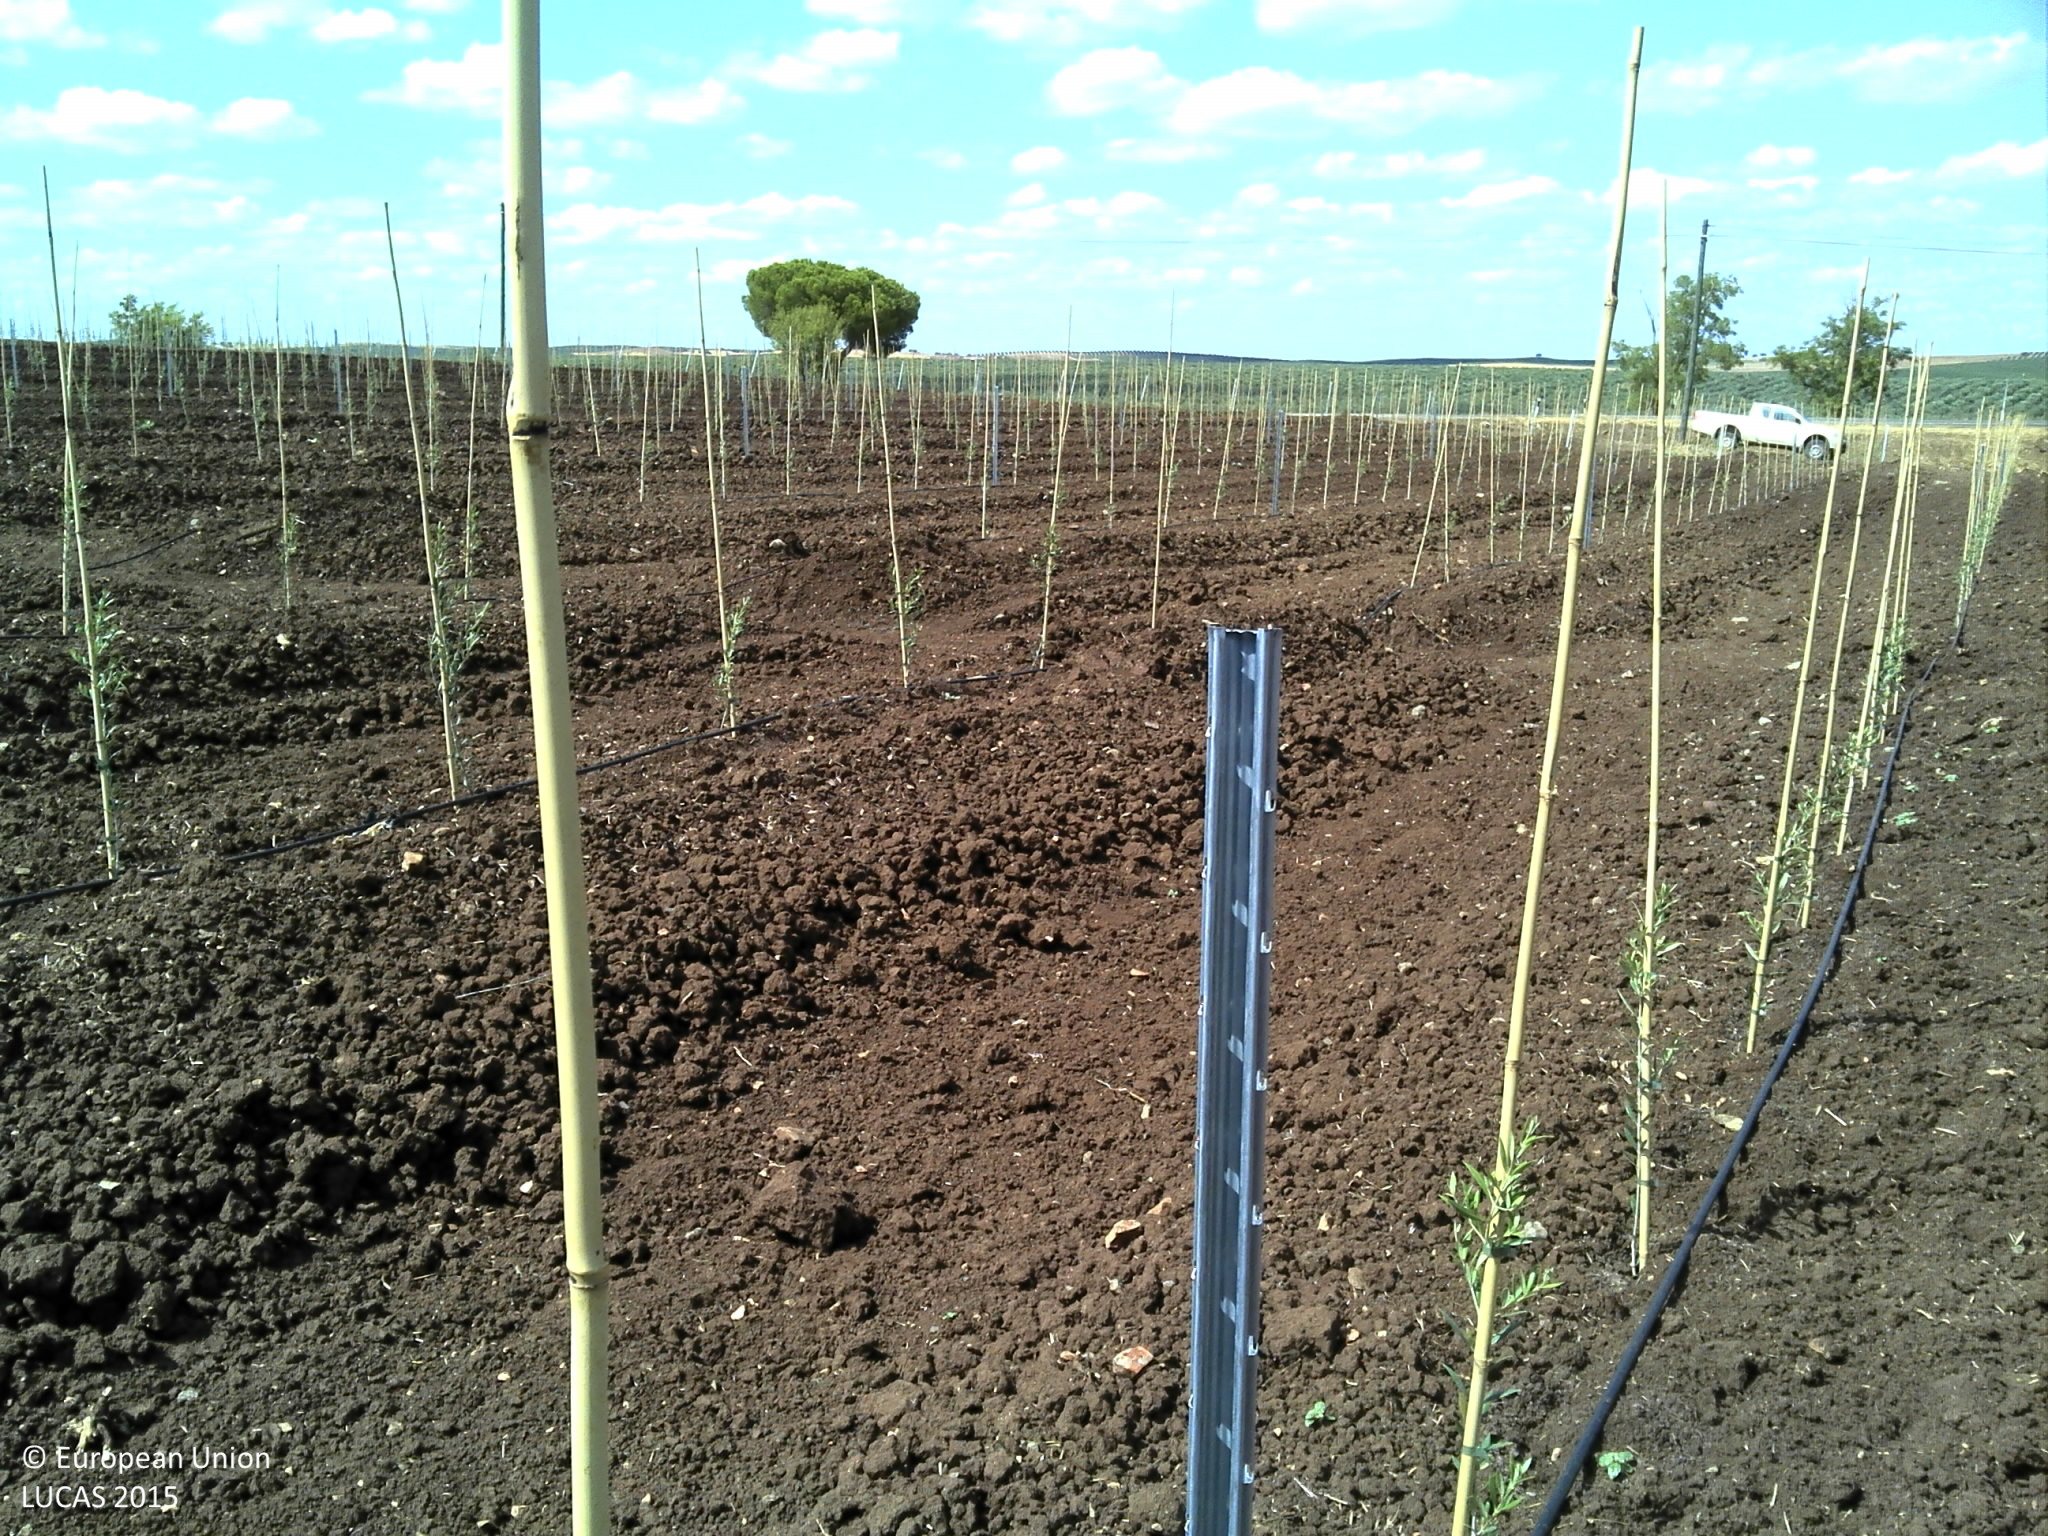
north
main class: Cropland
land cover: Olive groves
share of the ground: 10 - 25 %
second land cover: Other bare soil
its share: > 75 %
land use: Agriculture (excluding fallow land and kitchen gardens)
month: July
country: PT
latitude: 37.9993
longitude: -7.6858
